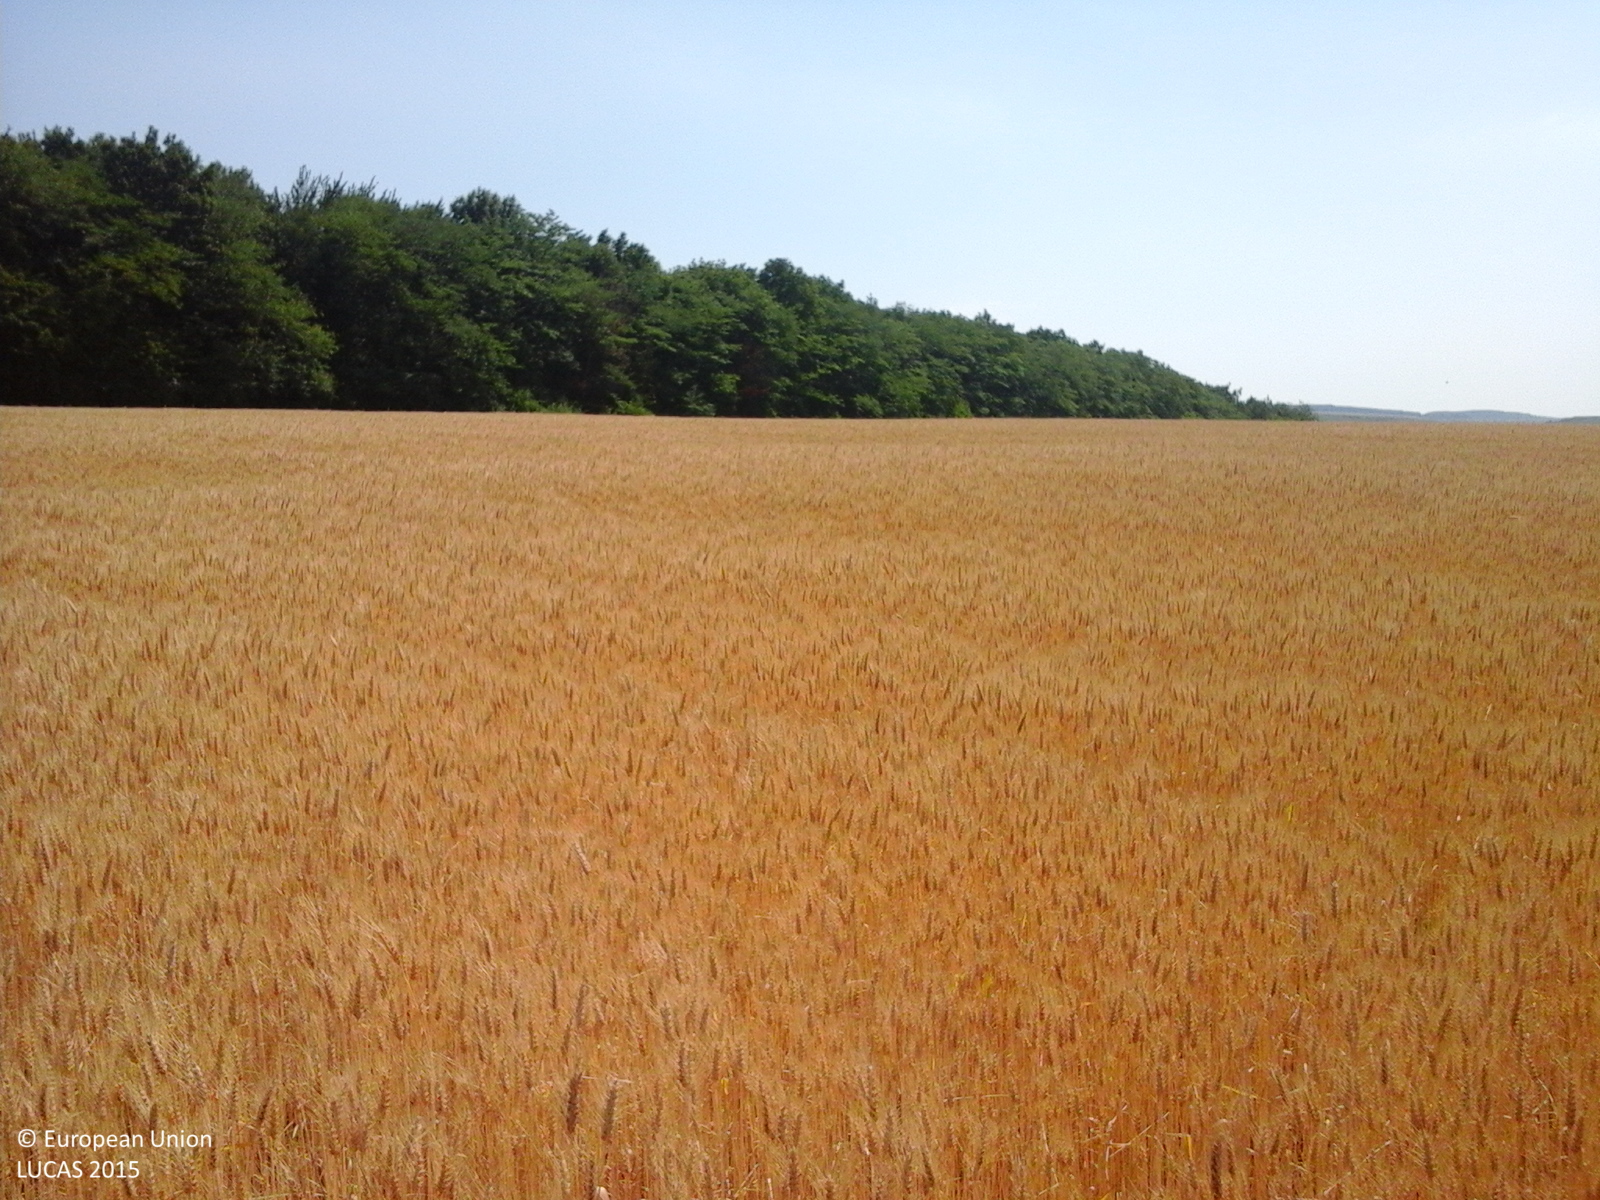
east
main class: Cropland
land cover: Common wheat
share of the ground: > 75 %
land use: Agriculture (excluding fallow land and kitchen gardens)
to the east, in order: Common wheat; Grass margins; Tracks; Grass margins; Broadleaved woodland
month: June
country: RO
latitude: 46.9575
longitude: 27.8250
